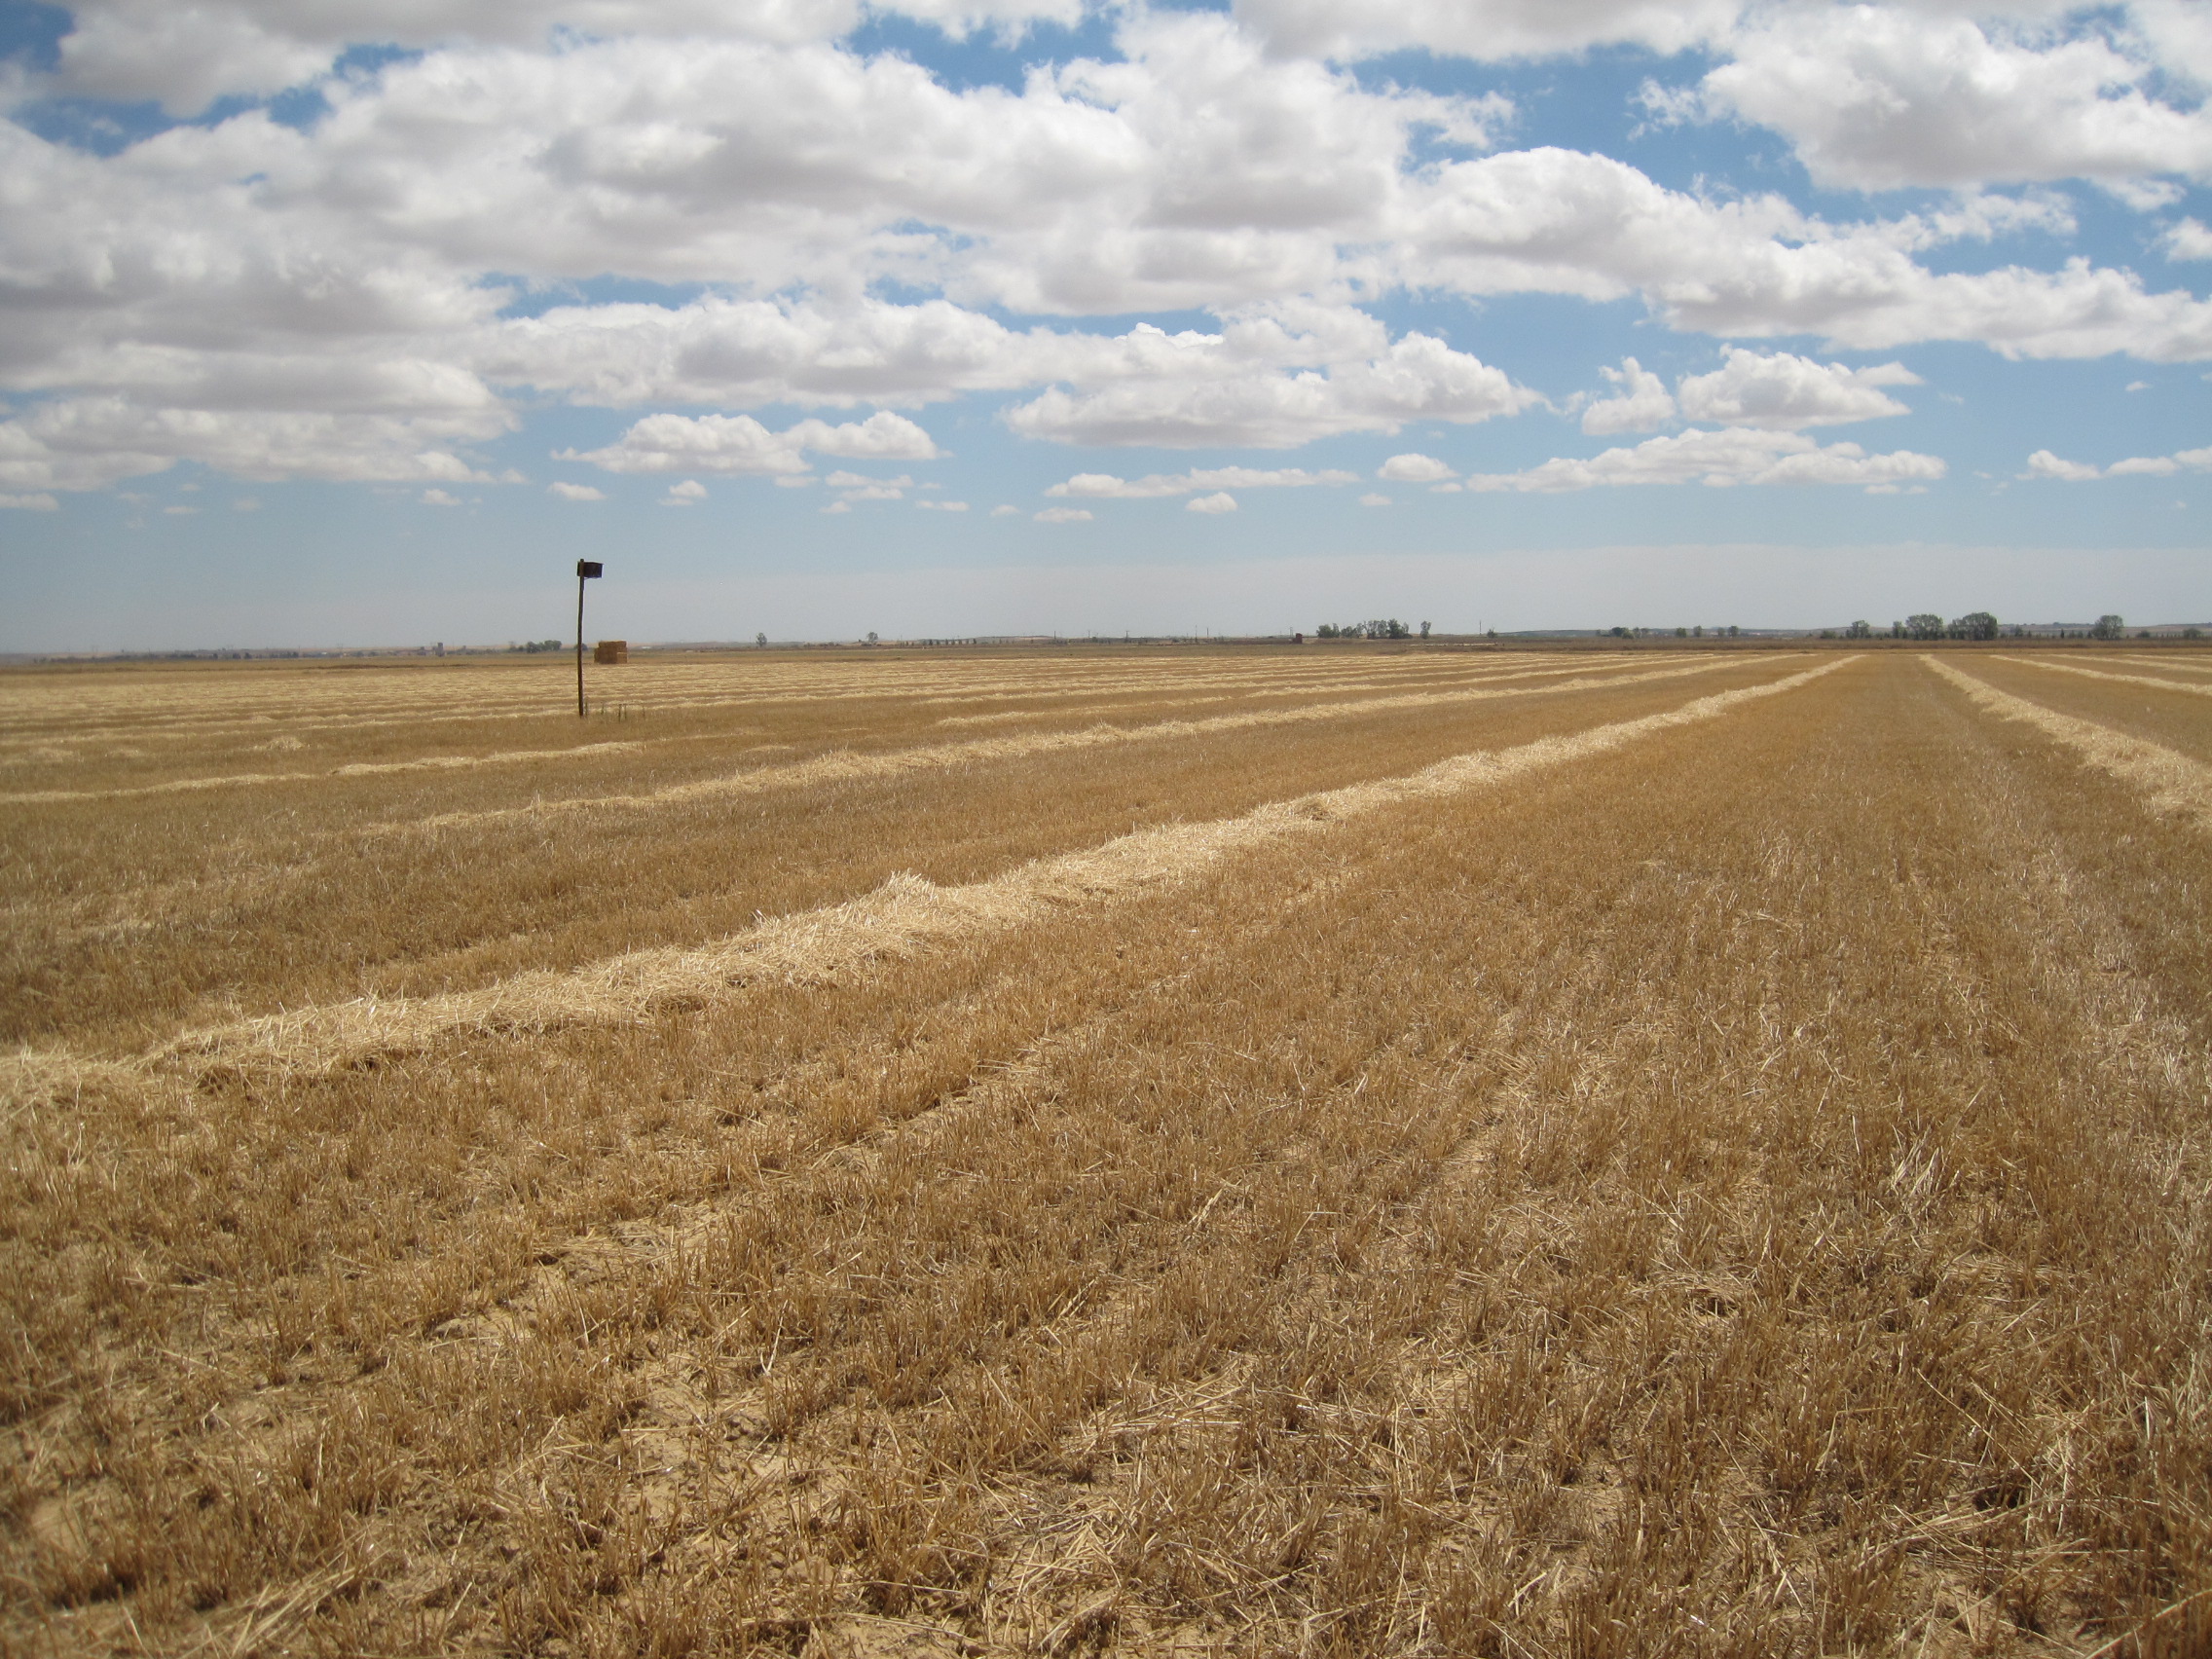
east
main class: Cropland
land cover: Barley
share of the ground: < 10 %
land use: Agriculture (excluding fallow land and kitchen gardens)
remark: Harvested field
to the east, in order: Barley
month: July
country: ES
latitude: 41.8861
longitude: -5.4265
